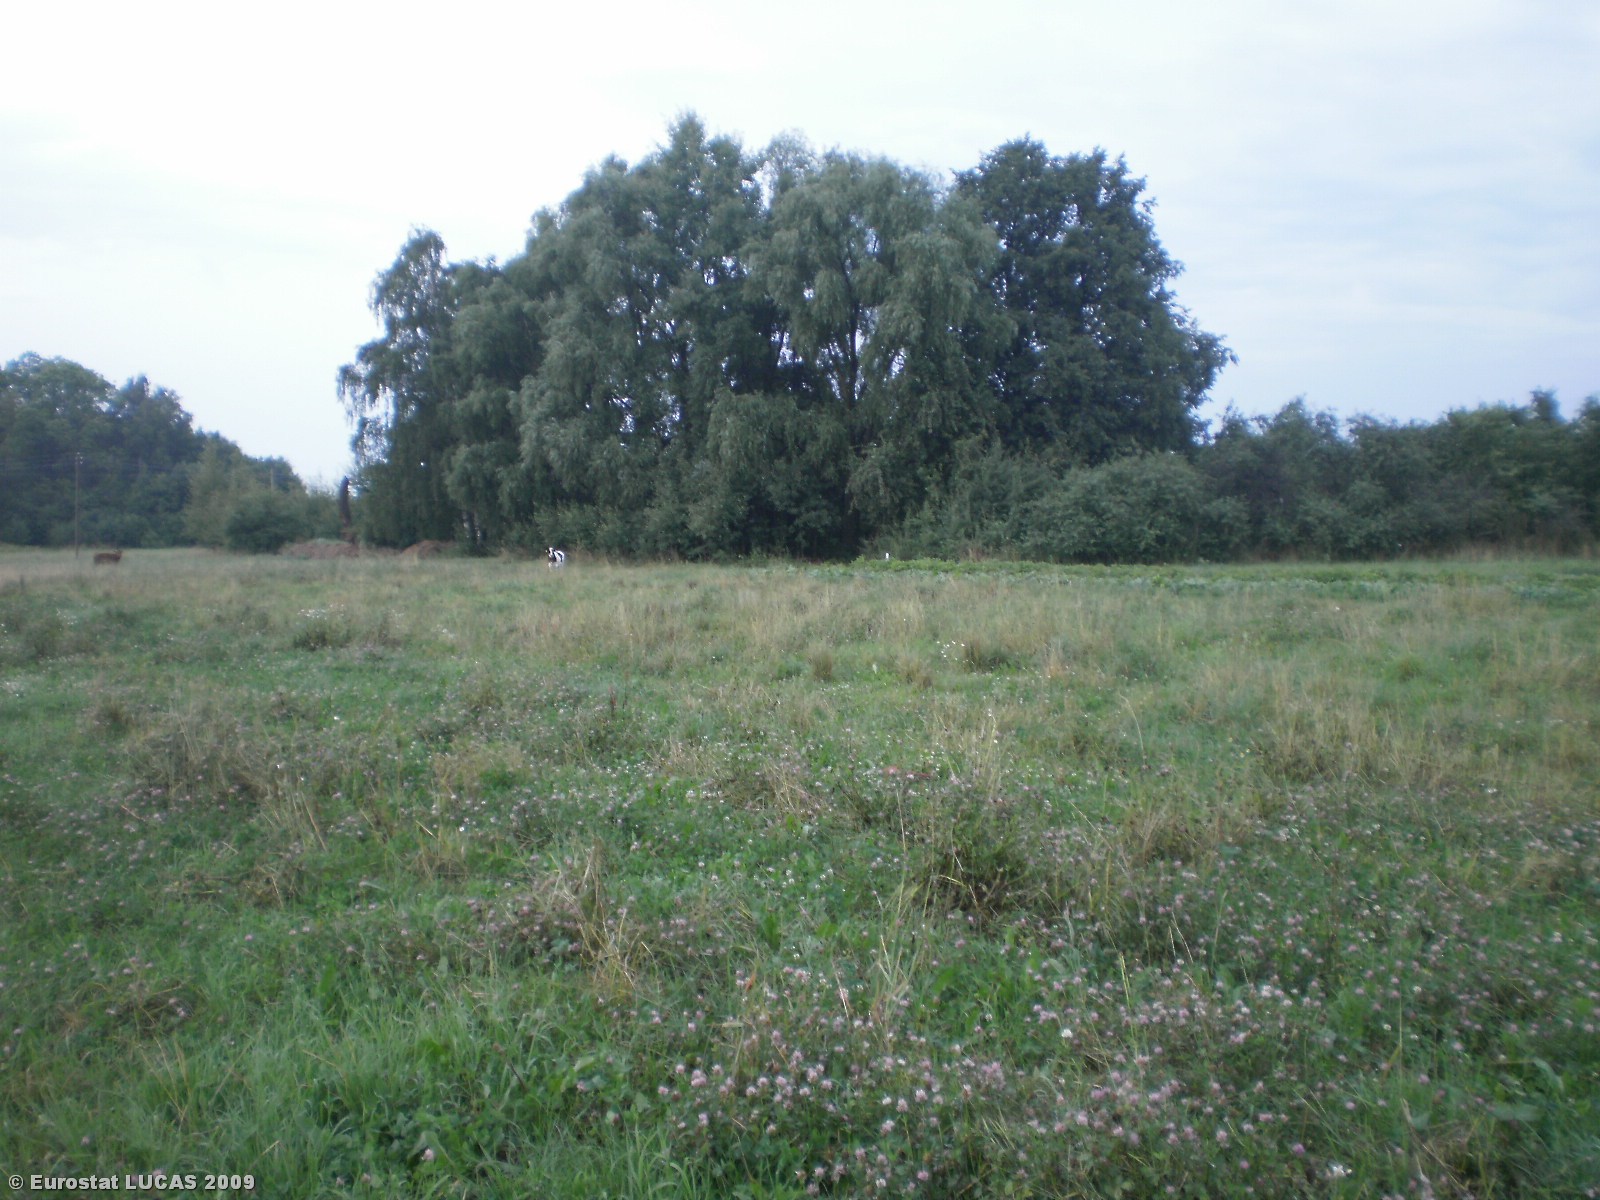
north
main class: Cropland
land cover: Clovers
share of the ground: > 75 %
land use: Agriculture (excluding fallow land and kitchen gardens)
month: July
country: LT
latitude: 55.8656
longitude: 24.8558
